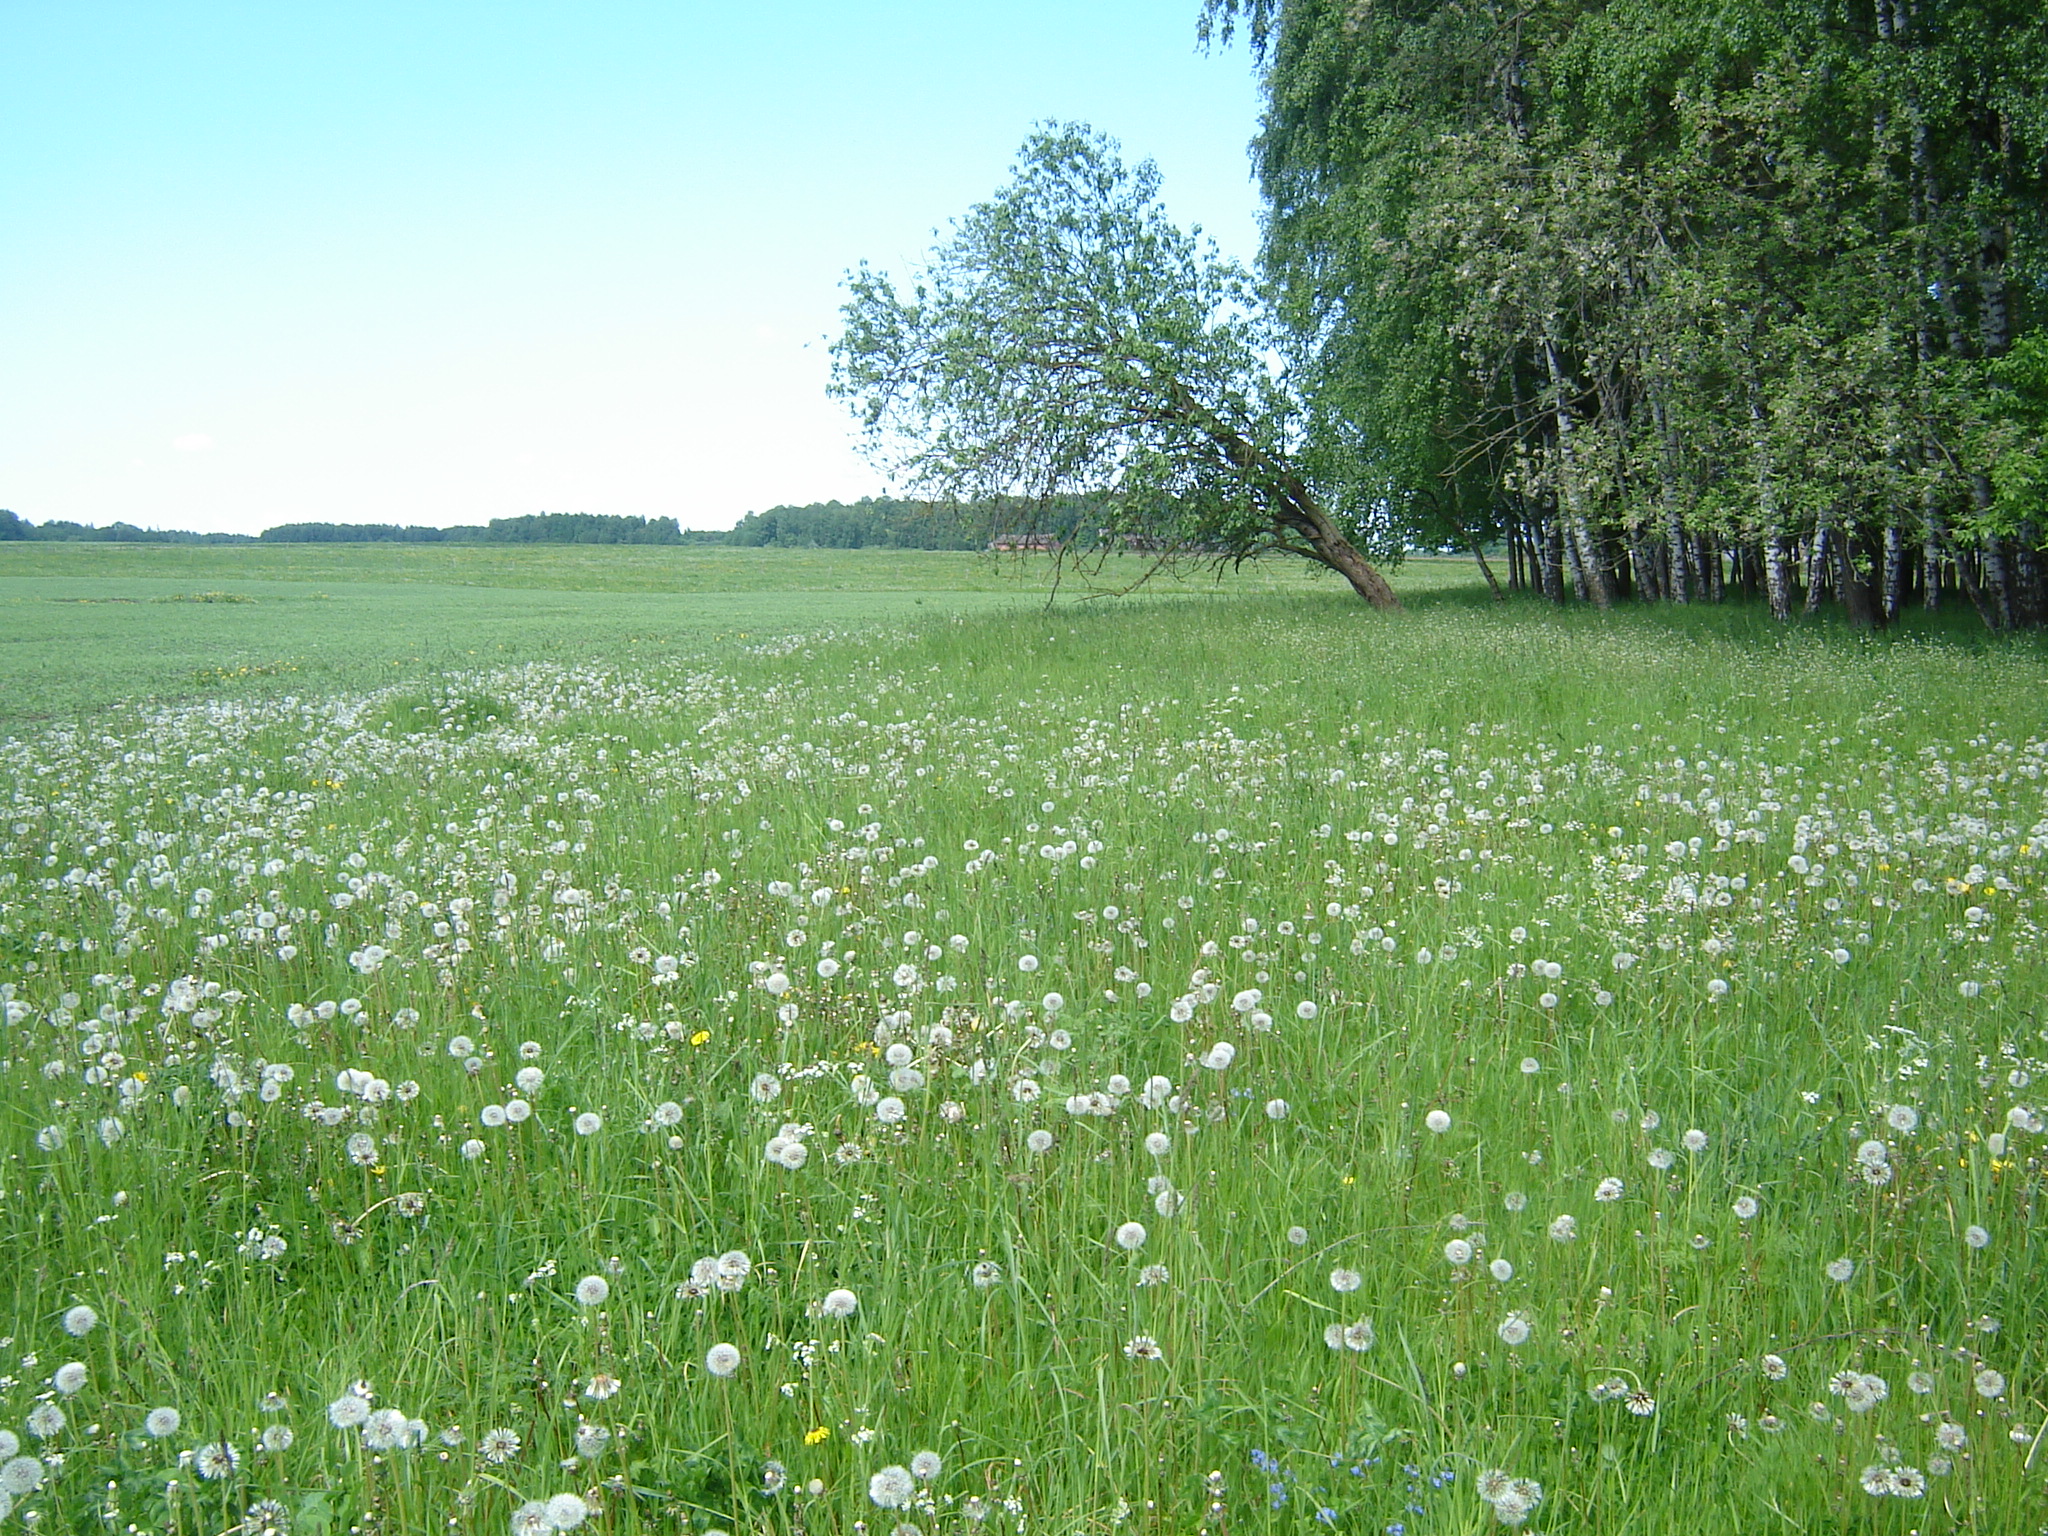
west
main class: Grassland
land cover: Grassland without tree/shrub cover
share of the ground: > 75 %
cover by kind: herbaceous plants 100 %
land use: Agriculture (excluding fallow land and kitchen gardens)
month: May
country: LT
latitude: 55.8321
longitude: 25.1374
